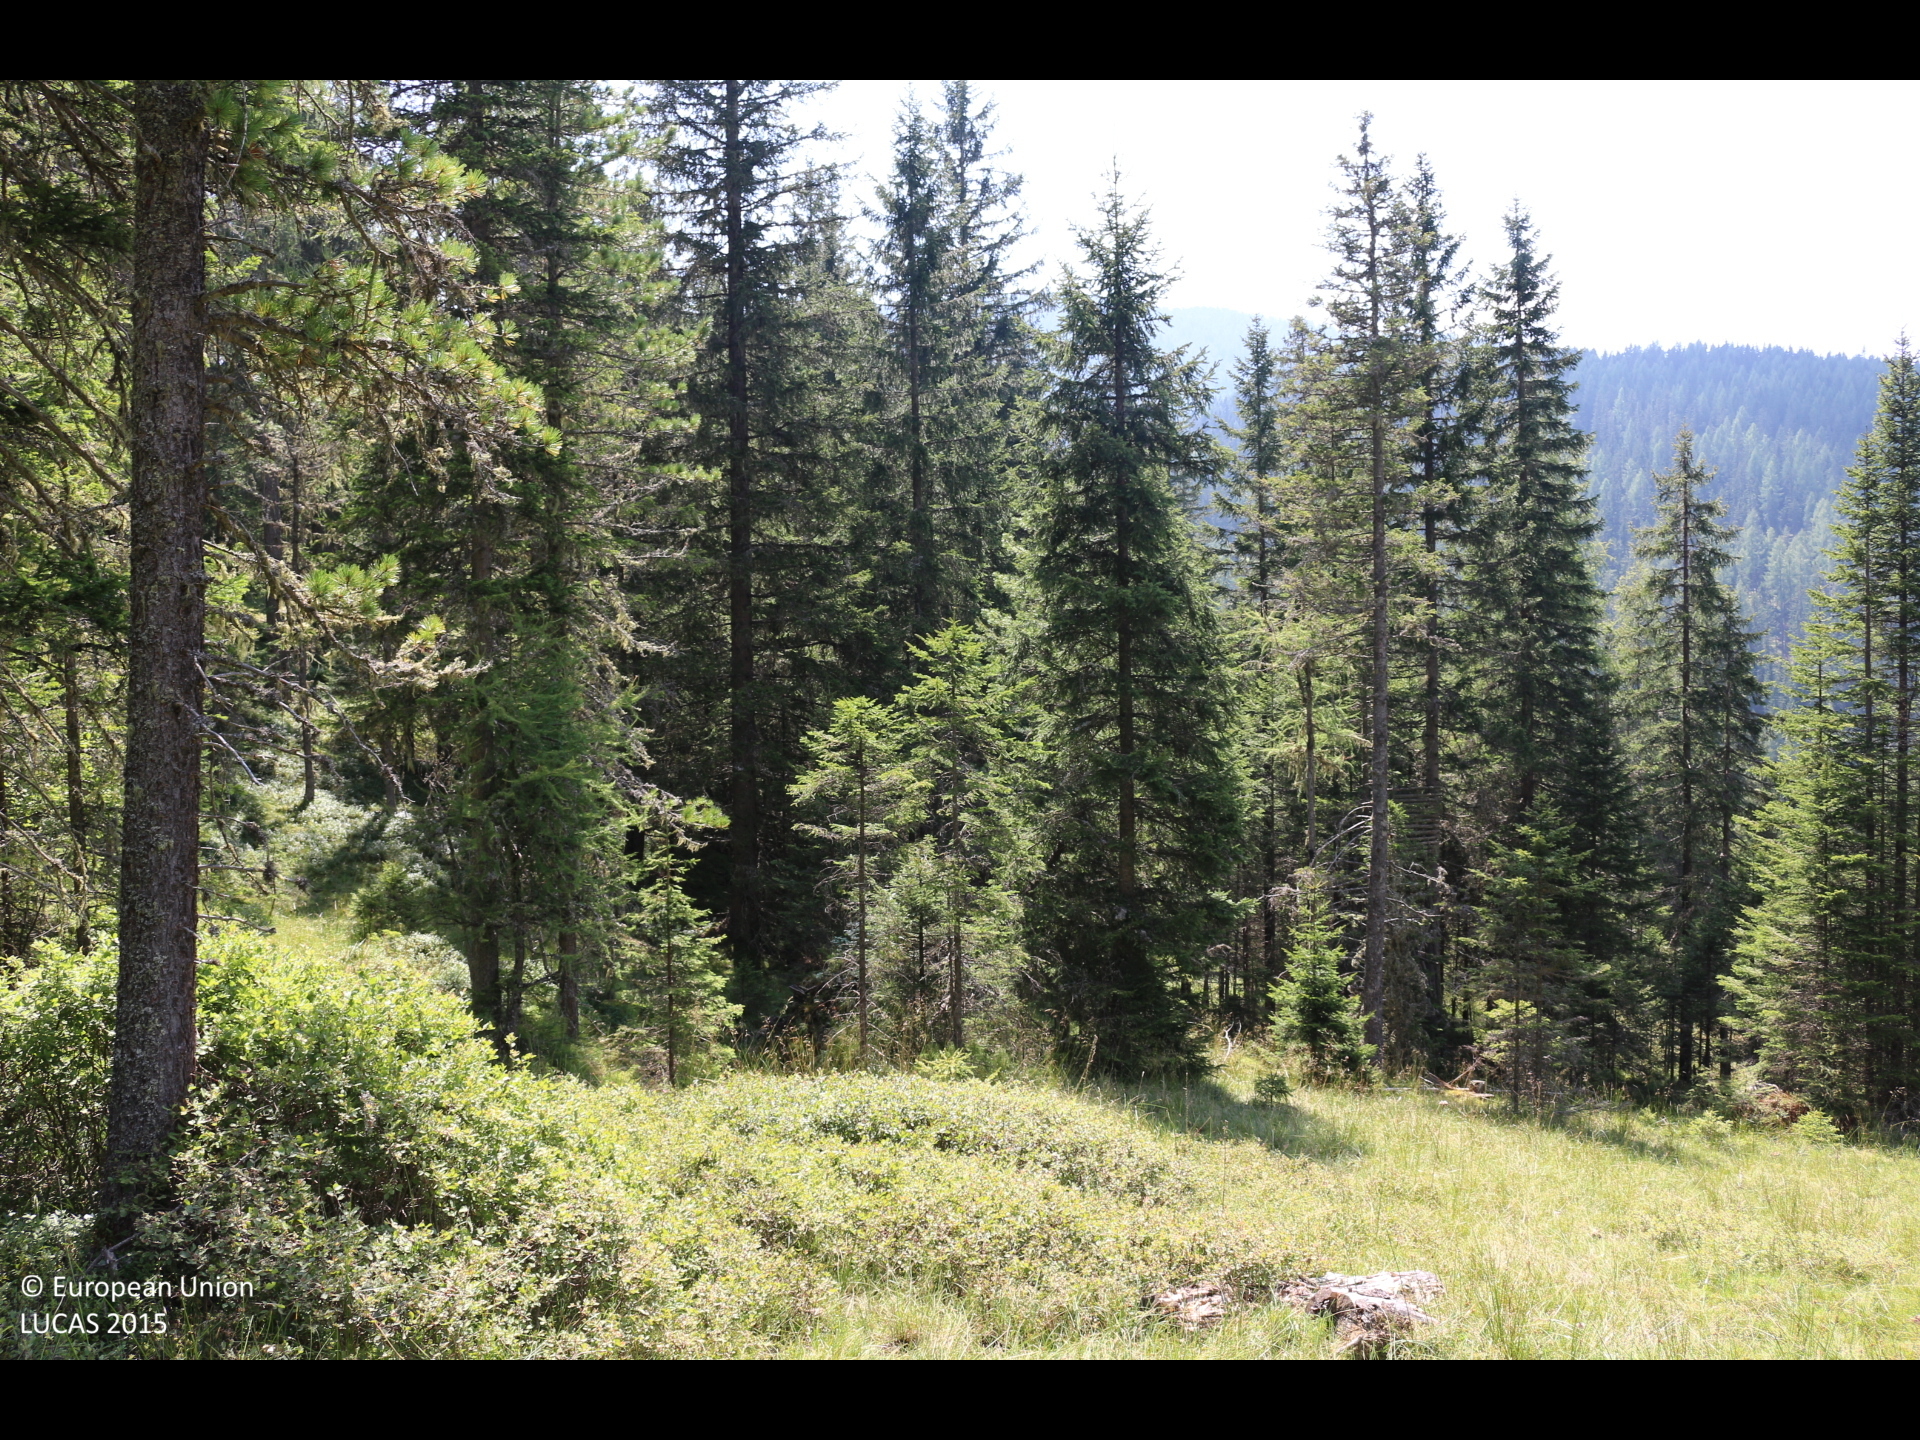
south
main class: Grassland
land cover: Grassland with sparse tree/shrub cover
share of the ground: > 75 %
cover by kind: herbaceous plants 95 %, coniferous forest trees 5 %
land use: Agriculture (excluding fallow land and kitchen gardens)
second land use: Forestry
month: August
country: AT
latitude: 46.8545
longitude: 13.9717
